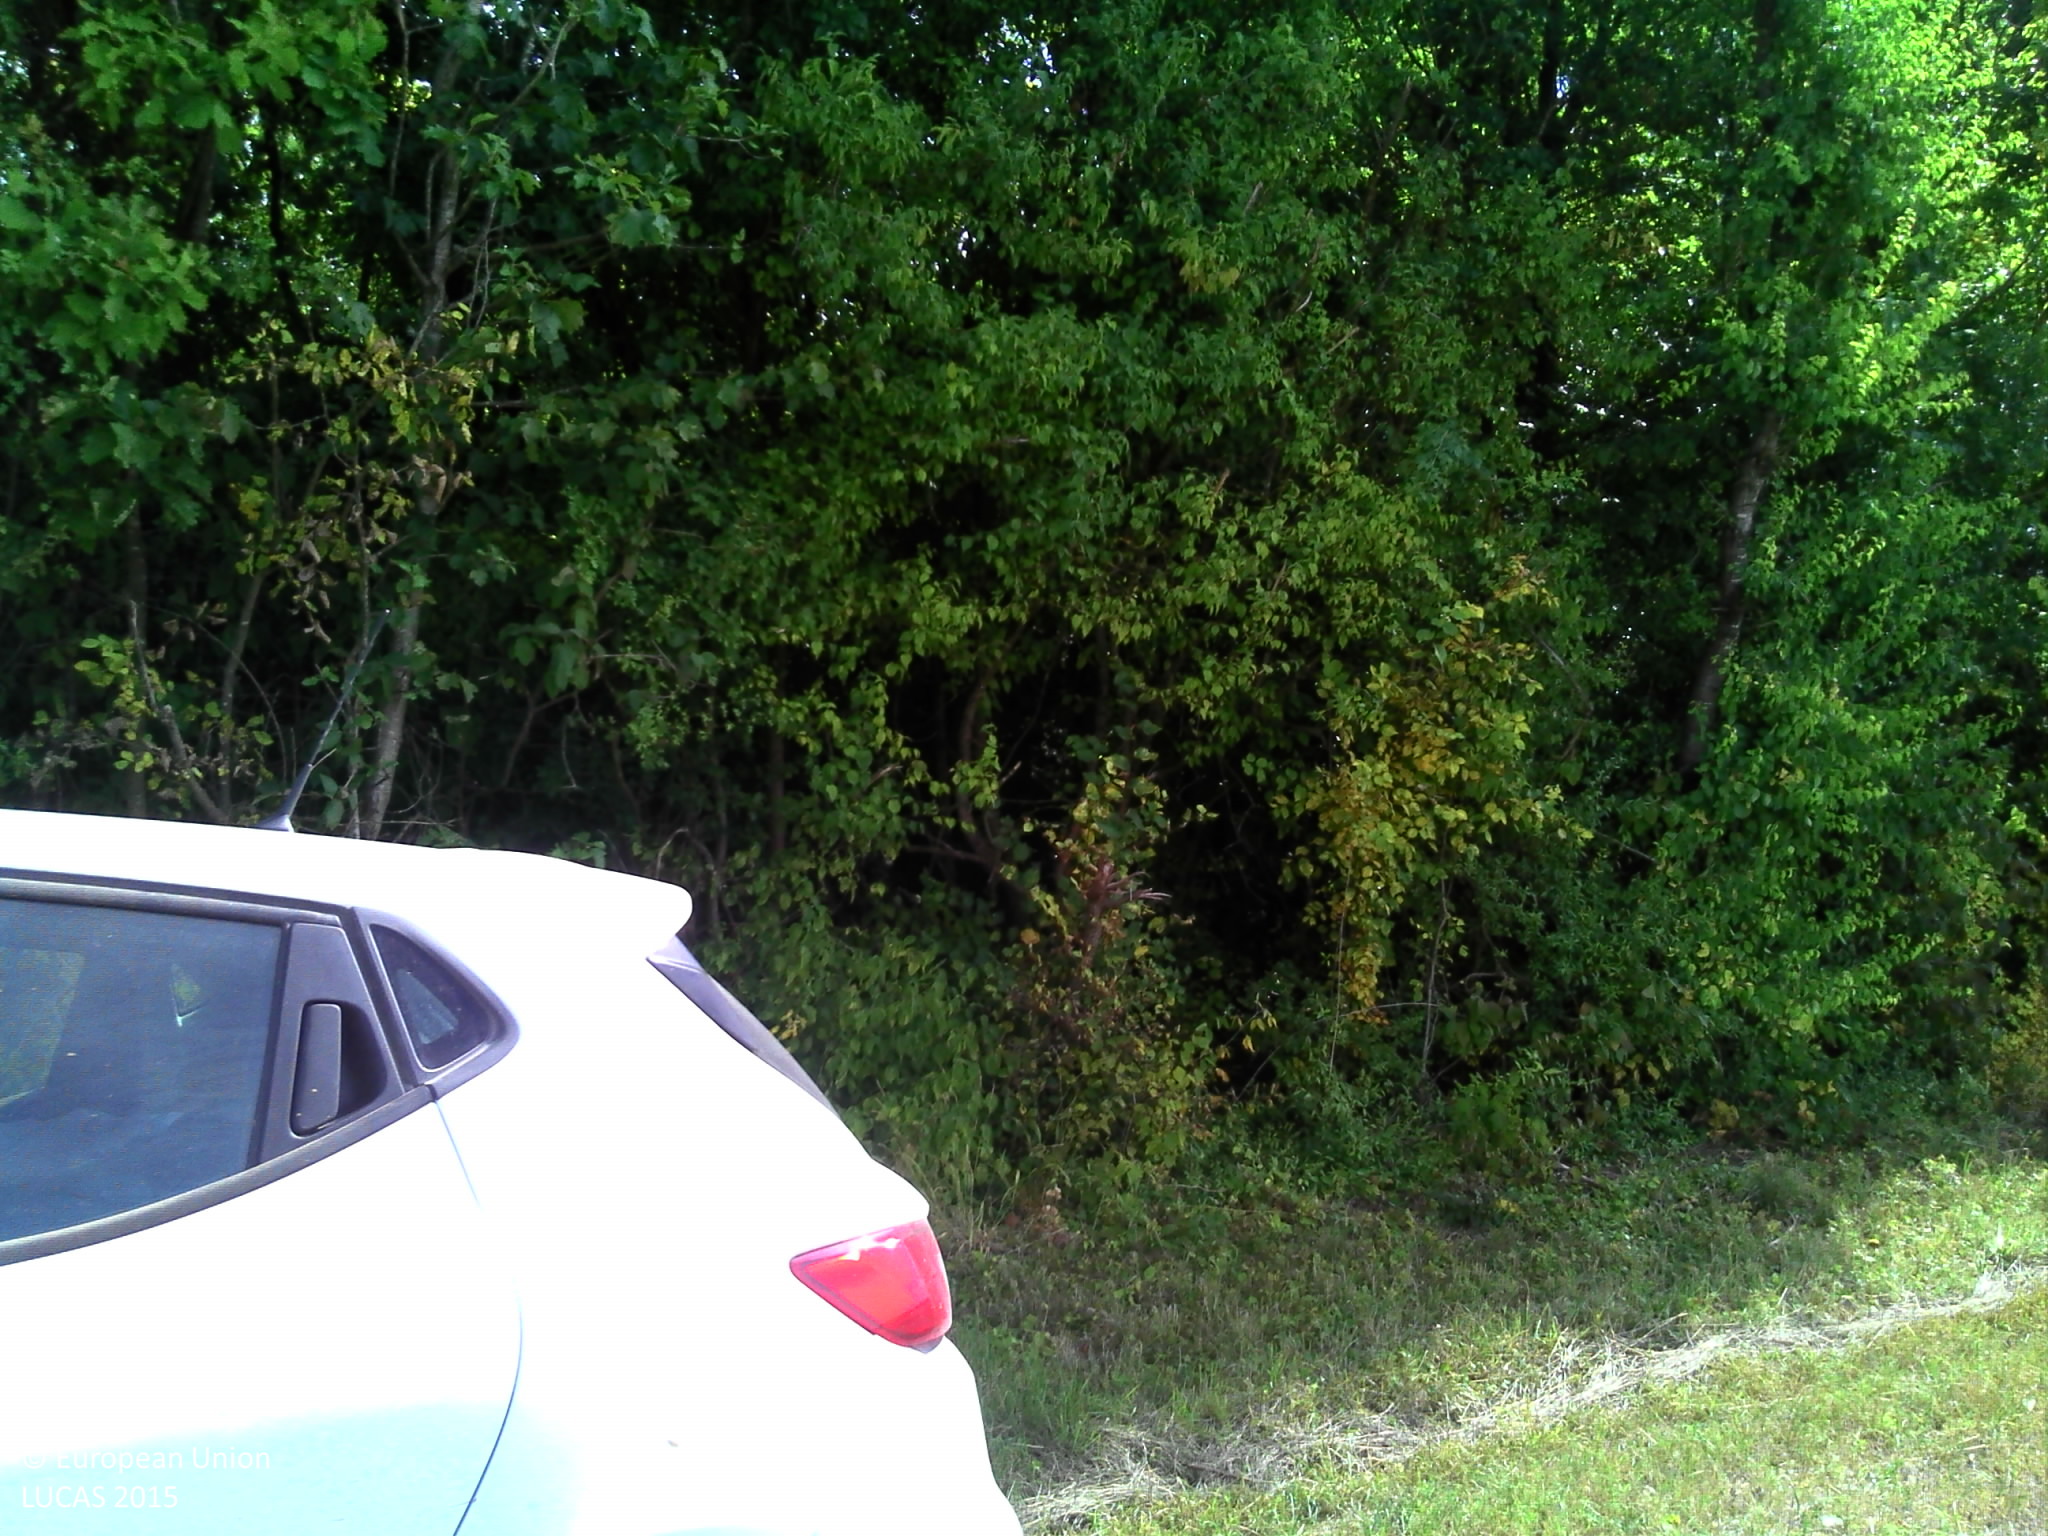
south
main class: Cropland
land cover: Sugar beet
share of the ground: > 75 %
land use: Agriculture (excluding fallow land and kitchen gardens)
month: August
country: FR
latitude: 48.1649
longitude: 2.4740
